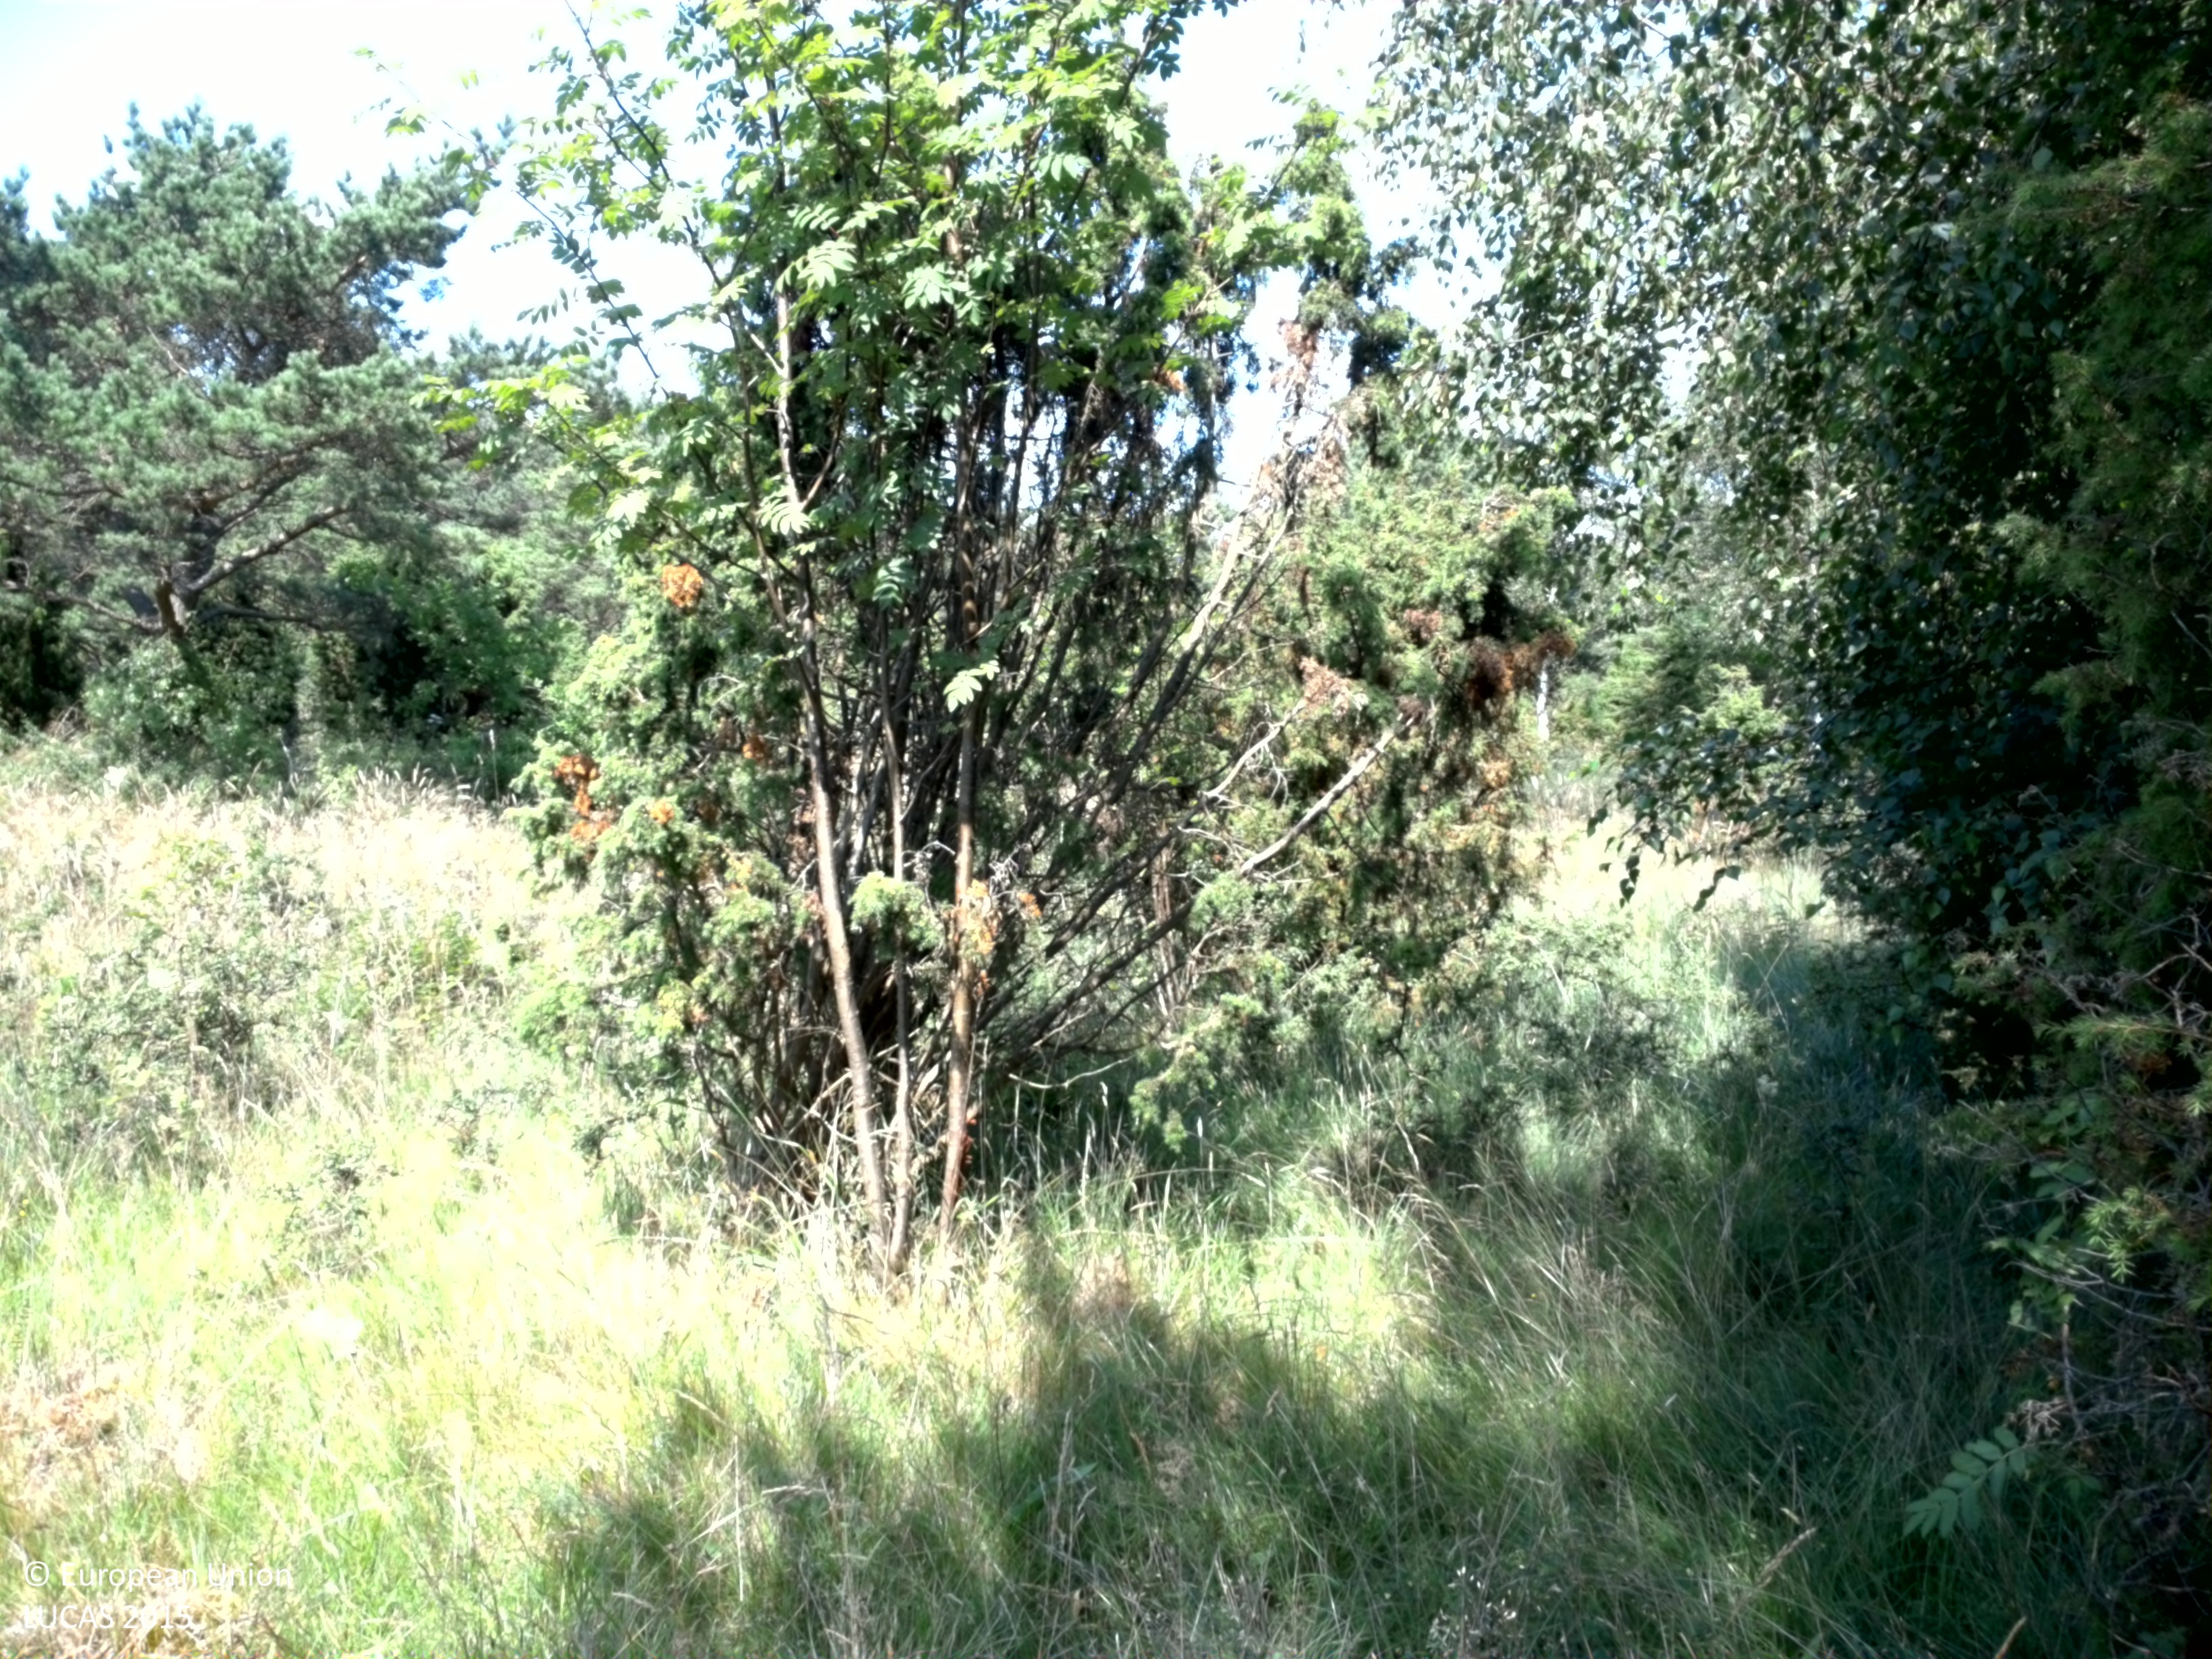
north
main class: Woodland
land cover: Pine dominated coniferous woodland
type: hemiboreal forest and nemoral coniferous forest and mixed broadleaved-coniferous forest
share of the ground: 50 - 75 %
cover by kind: coniferous forest trees 50 %, herbaceous plants 30 %, shrubs 20 %
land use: Amenities, museums, leisure
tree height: > 5 m
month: July
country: SE
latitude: 57.3219
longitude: 18.6958
